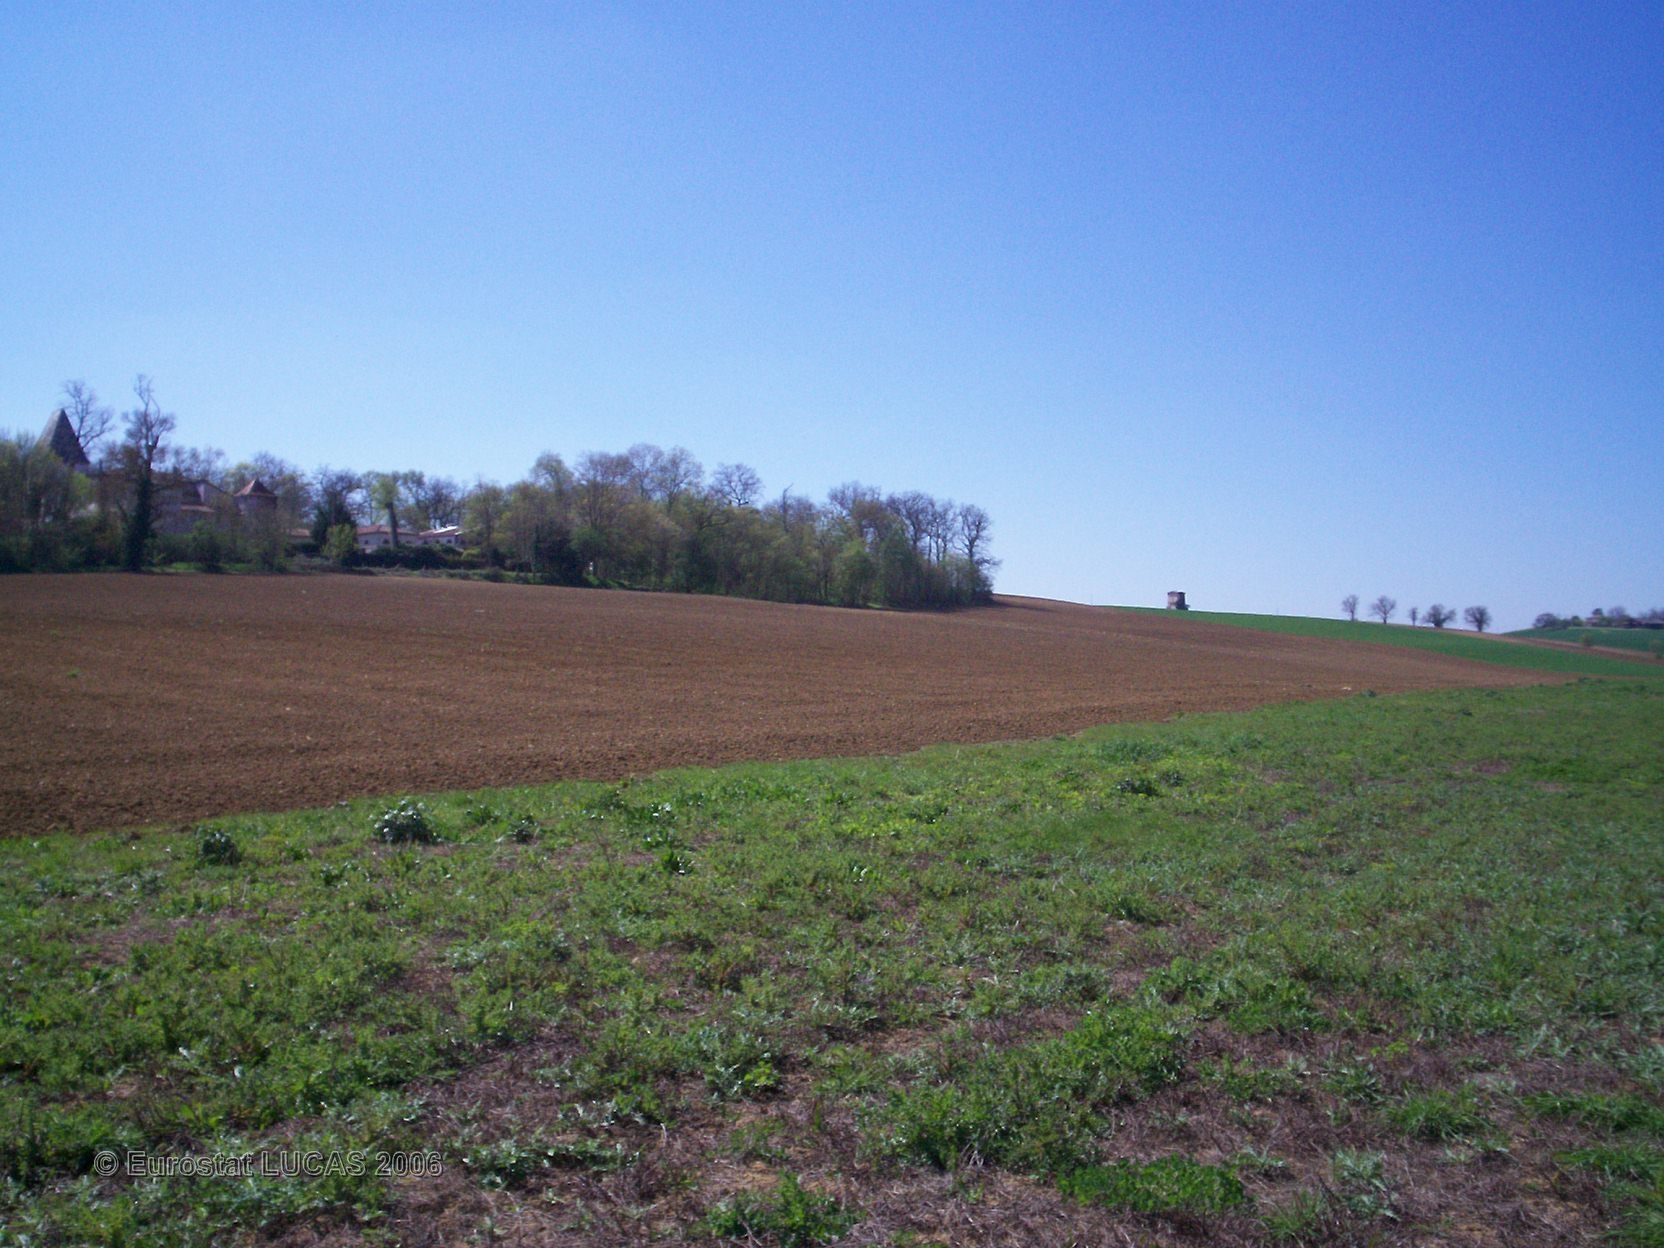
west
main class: Grassland
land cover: Grassland without tree/shrub cover
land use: Agriculture (excluding fallow land and kitchen gardens)
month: April
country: FR
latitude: 43.8640
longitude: 0.9529
